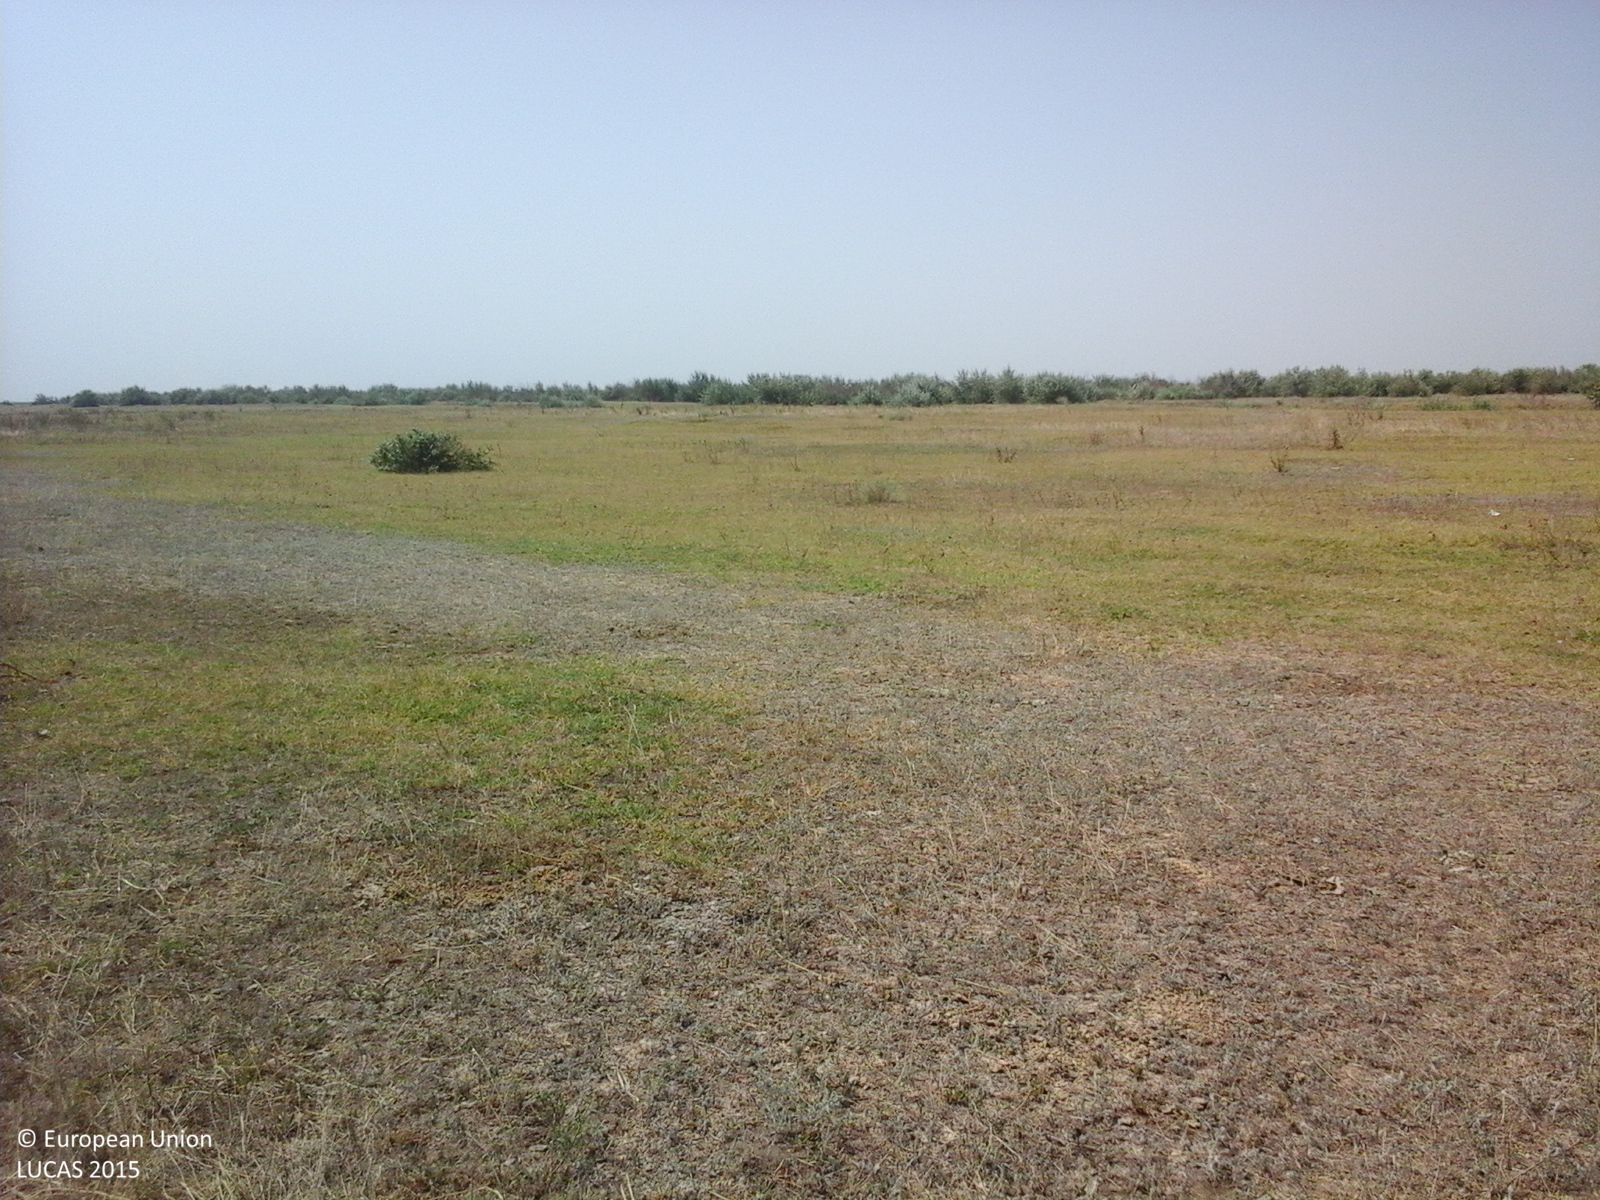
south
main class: Grassland
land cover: Grassland without tree/shrub cover
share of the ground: > 75 %
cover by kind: herbaceous plants 100 %
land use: Agriculture (excluding fallow land and kitchen gardens)
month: August
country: RO
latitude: 45.3729
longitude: 27.7161
